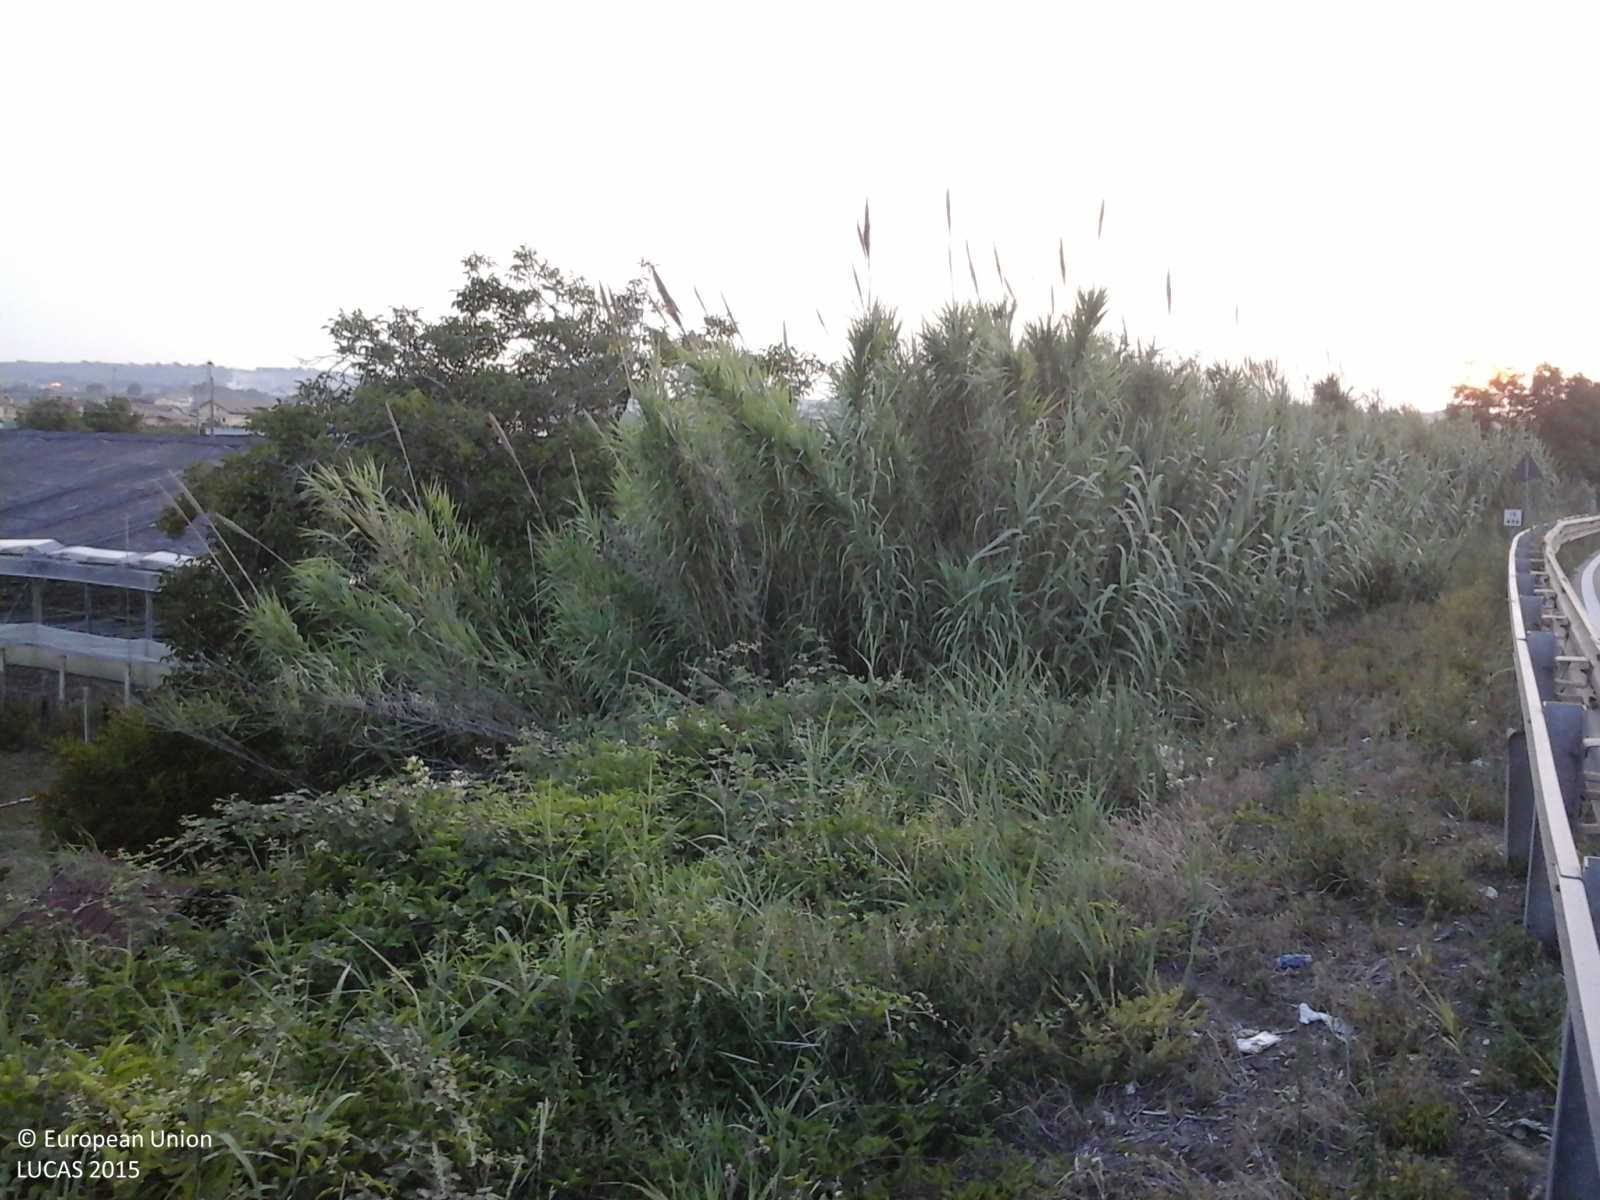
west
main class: Grassland
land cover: Grassland without tree/shrub cover
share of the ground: > 75 %
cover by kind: herbaceous plants 100 %
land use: Agriculture (excluding fallow land and kitchen gardens)
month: July
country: IT
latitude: 42.3989
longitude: 14.3244
